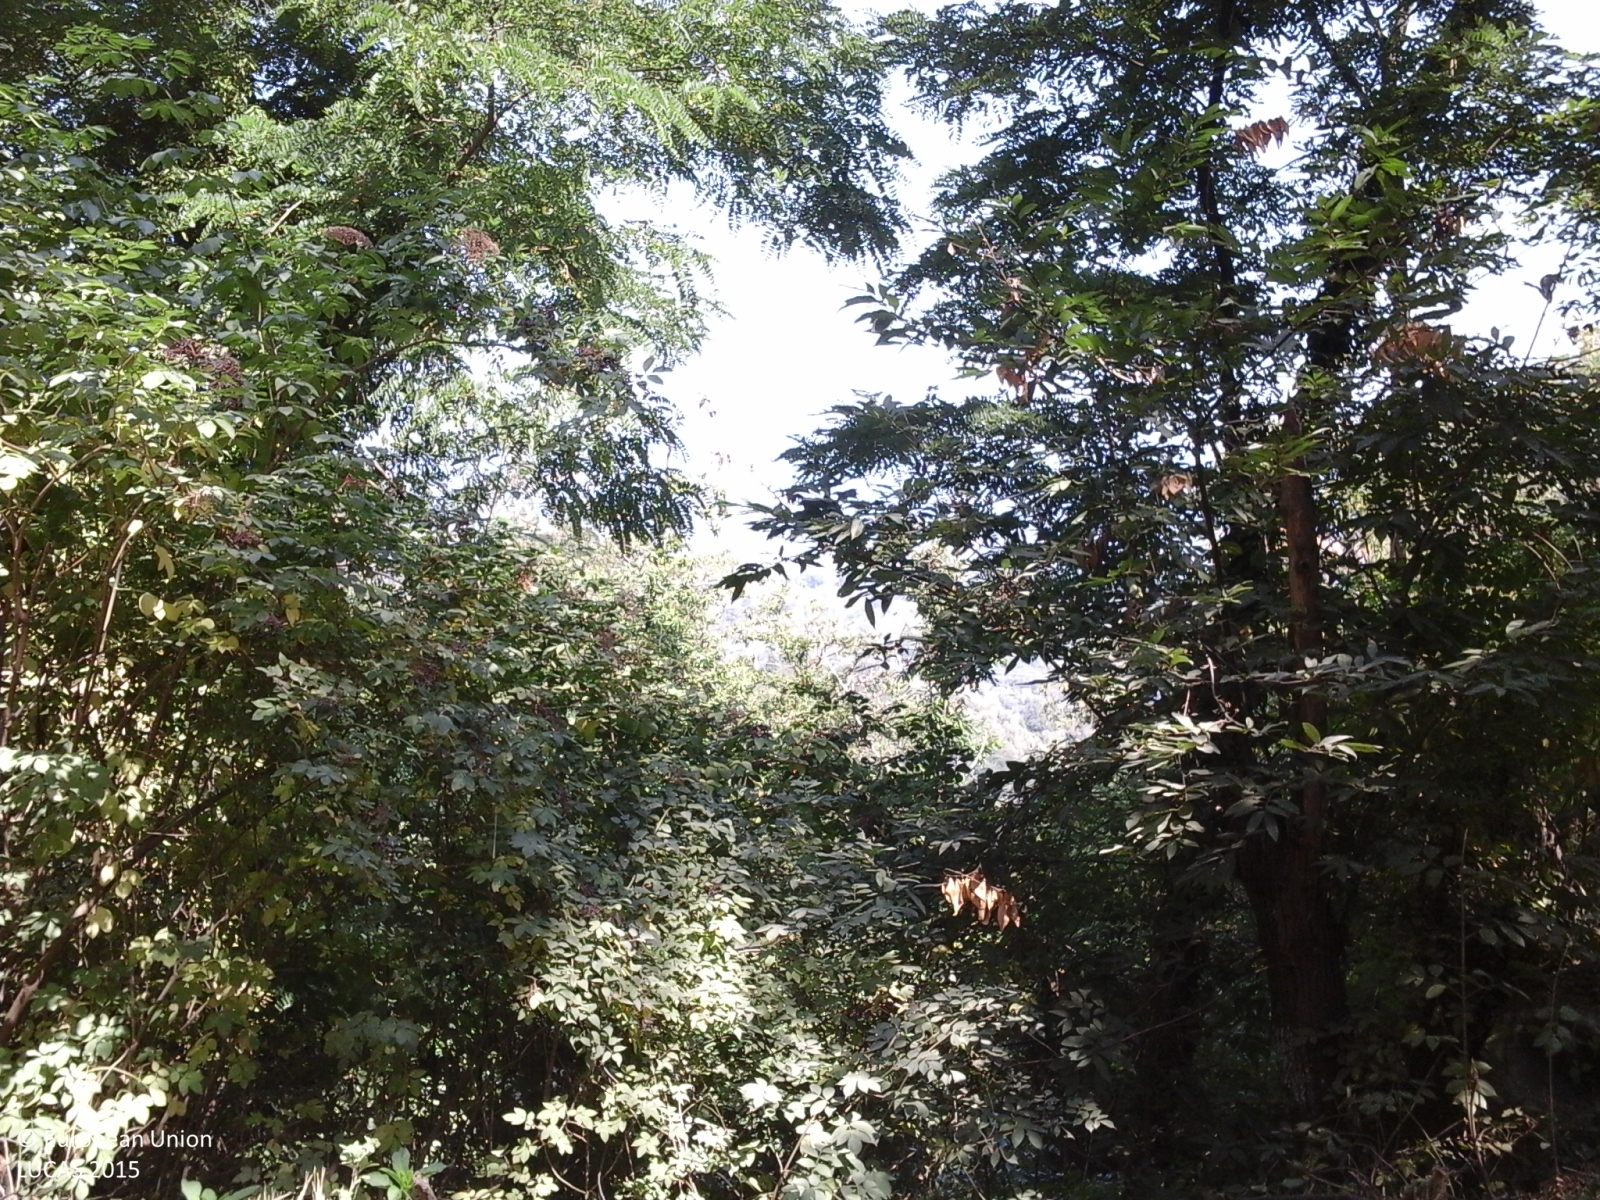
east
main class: Woodland
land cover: Broadleaved woodland
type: thermophilous deciduous forest
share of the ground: > 75 %
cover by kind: broadleaved forest trees 75 %, coniferous forest trees 25 %
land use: Forestry
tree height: > 5 m
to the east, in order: Broadleaved woodland; Artificial constructions; Paved roads, cycling and walking lanes; Electric lines; Grass margins; Shruby margins; Tracks; Shrubland with sparse tree cover; Olive groves
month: July
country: IT
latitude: 44.0980
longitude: 9.9128
